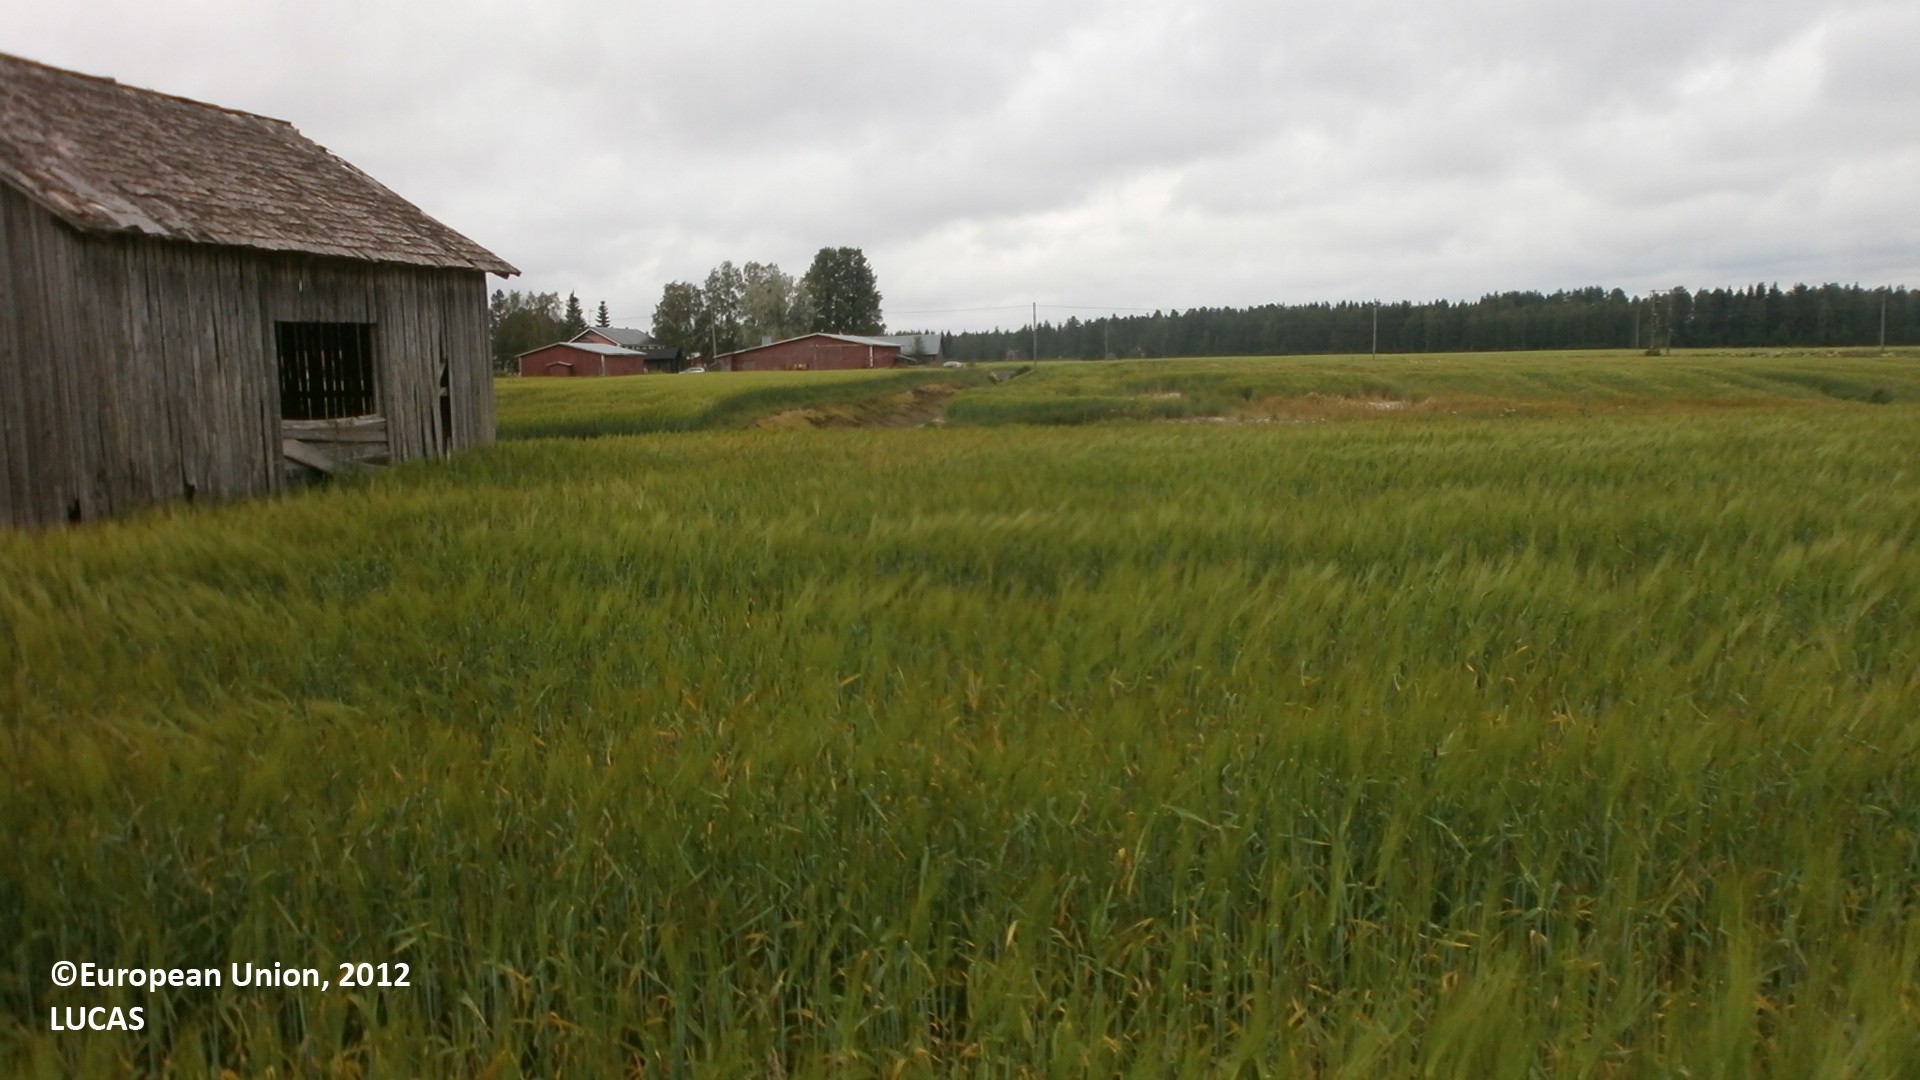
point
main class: Cropland
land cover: Barley
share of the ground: > 75 %
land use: Agriculture (excluding fallow land and kitchen gardens)
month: July
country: FI
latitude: 64.1997
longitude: 24.1725
